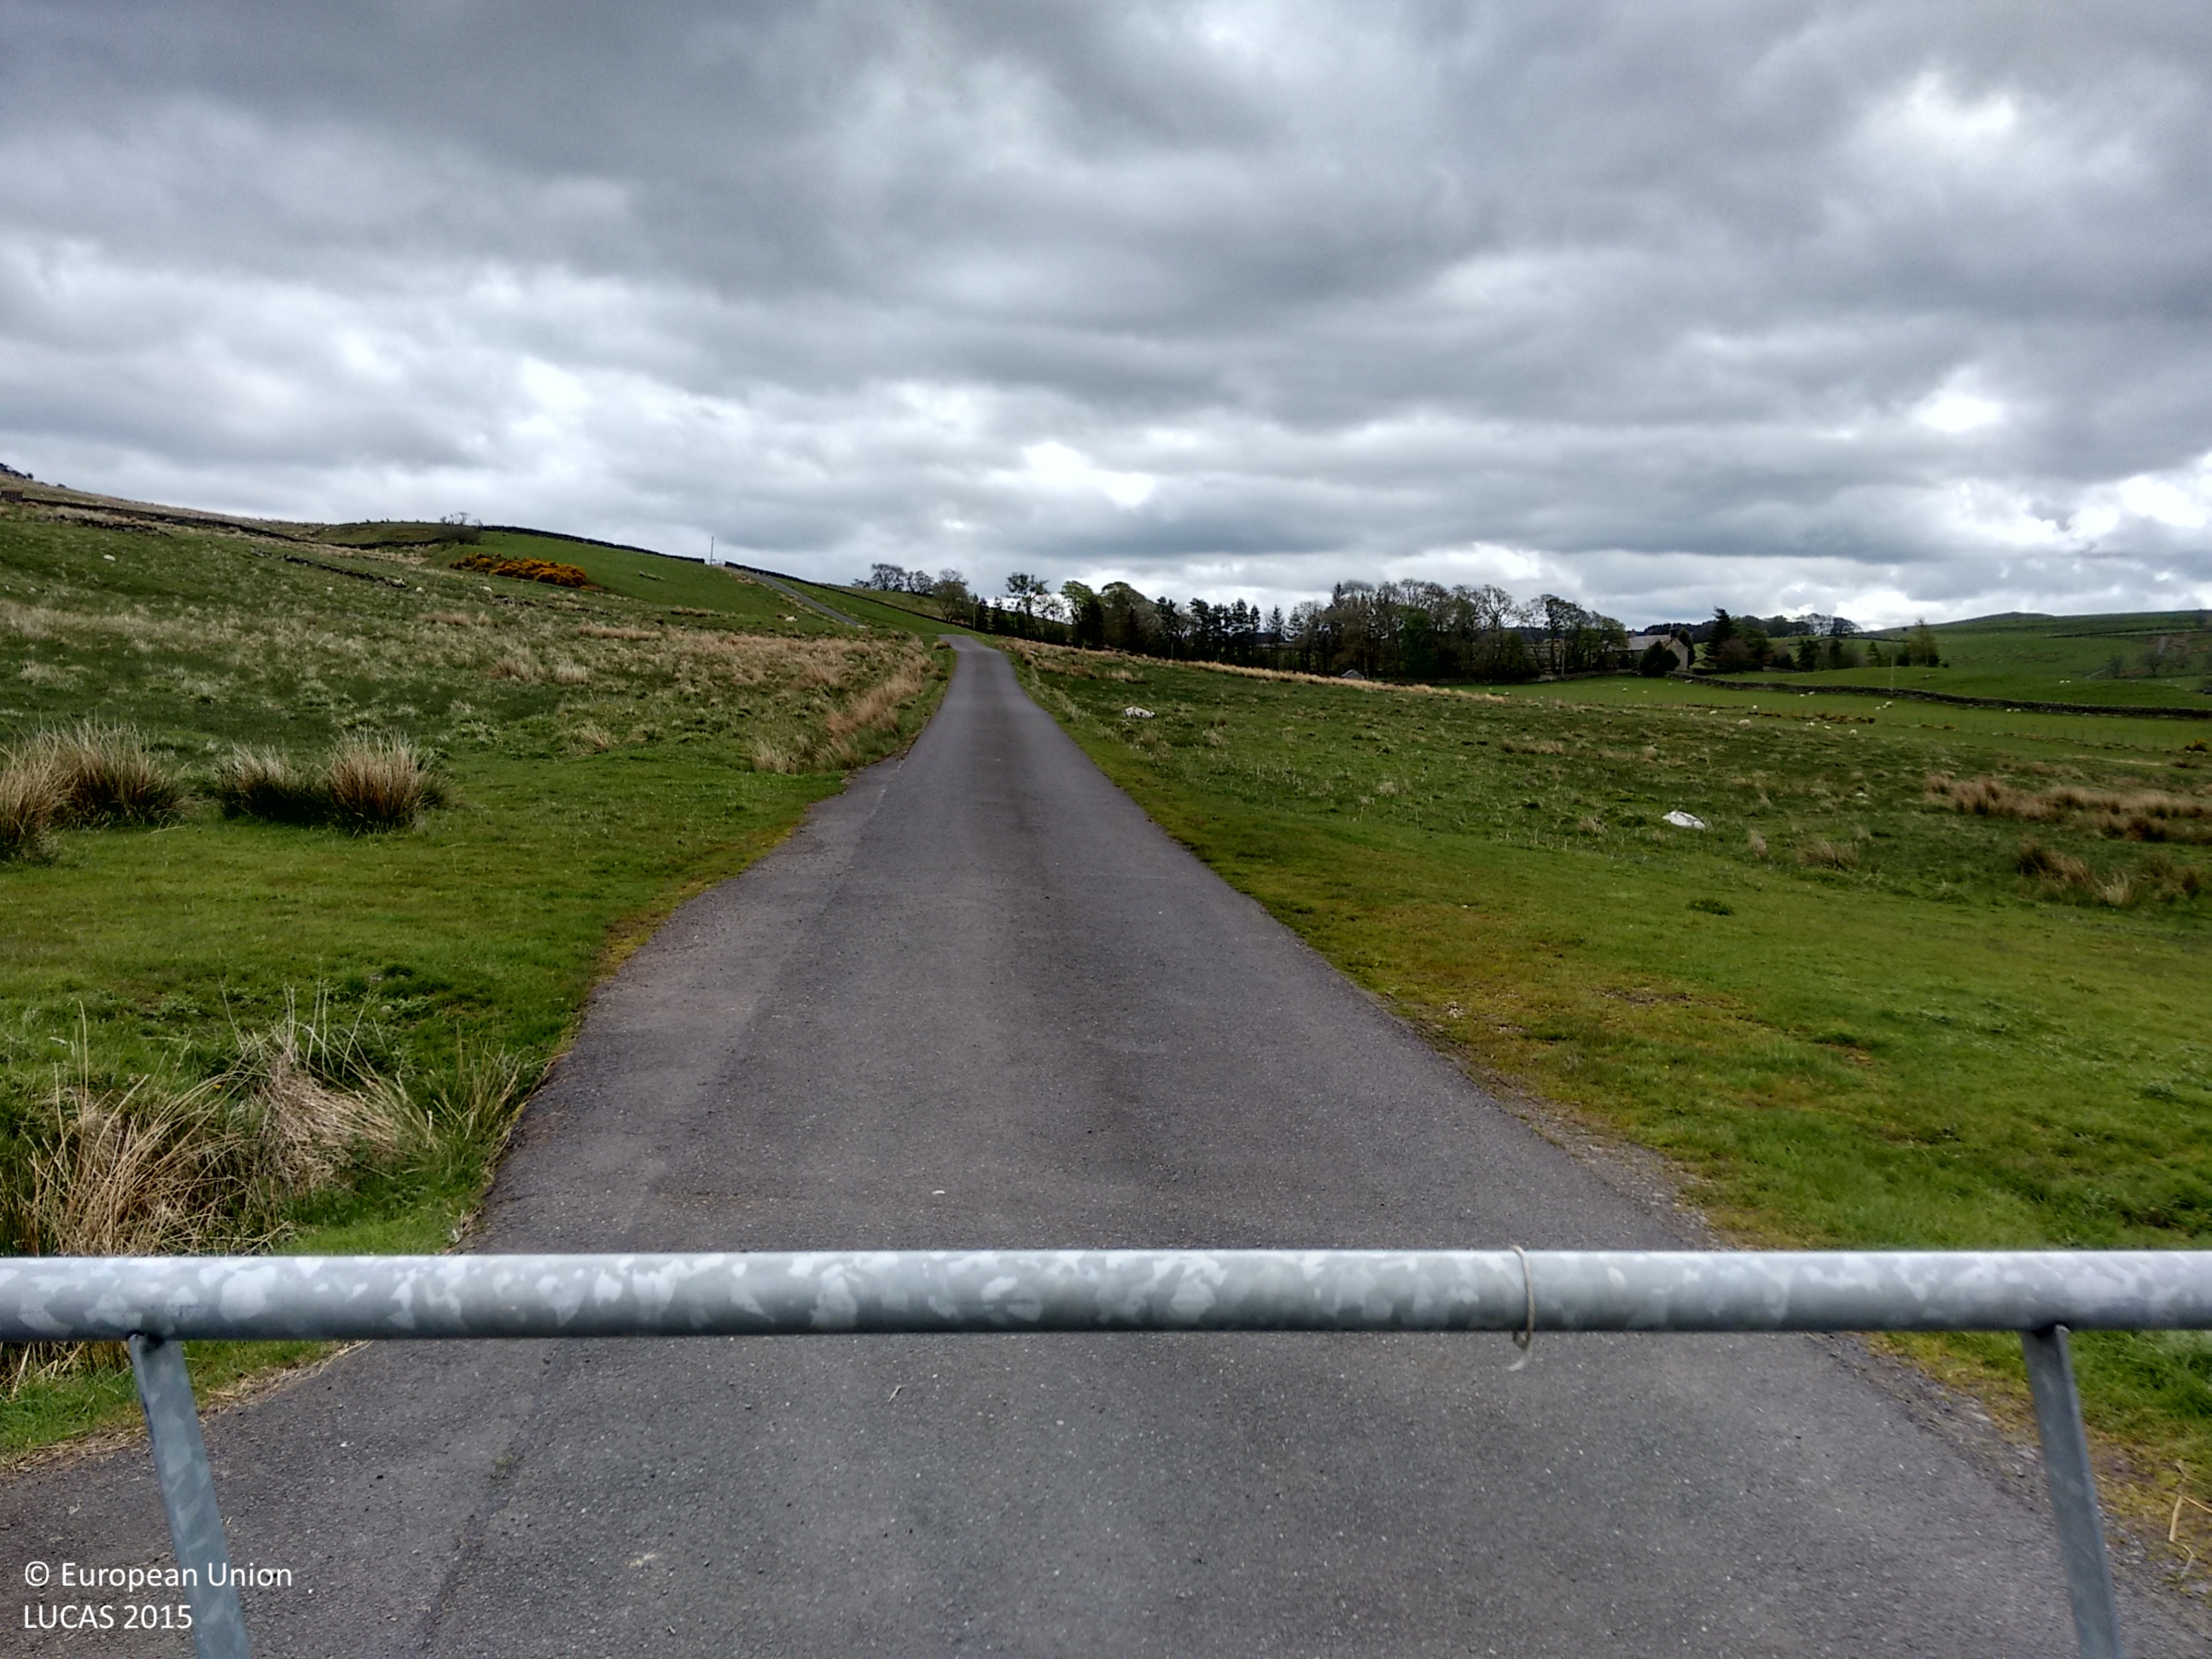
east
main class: Shrubland
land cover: Shrubland without tree cover
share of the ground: > 75 %
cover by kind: shrubs 100 %
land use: Semi-natural and natural areas not in use
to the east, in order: Shrubland without tree cover; Rivers and streams; Shrubland without tree cover; Rivers and streams; Shrubland without tree cover
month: May
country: GB
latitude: 55.1759
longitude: -2.0989
